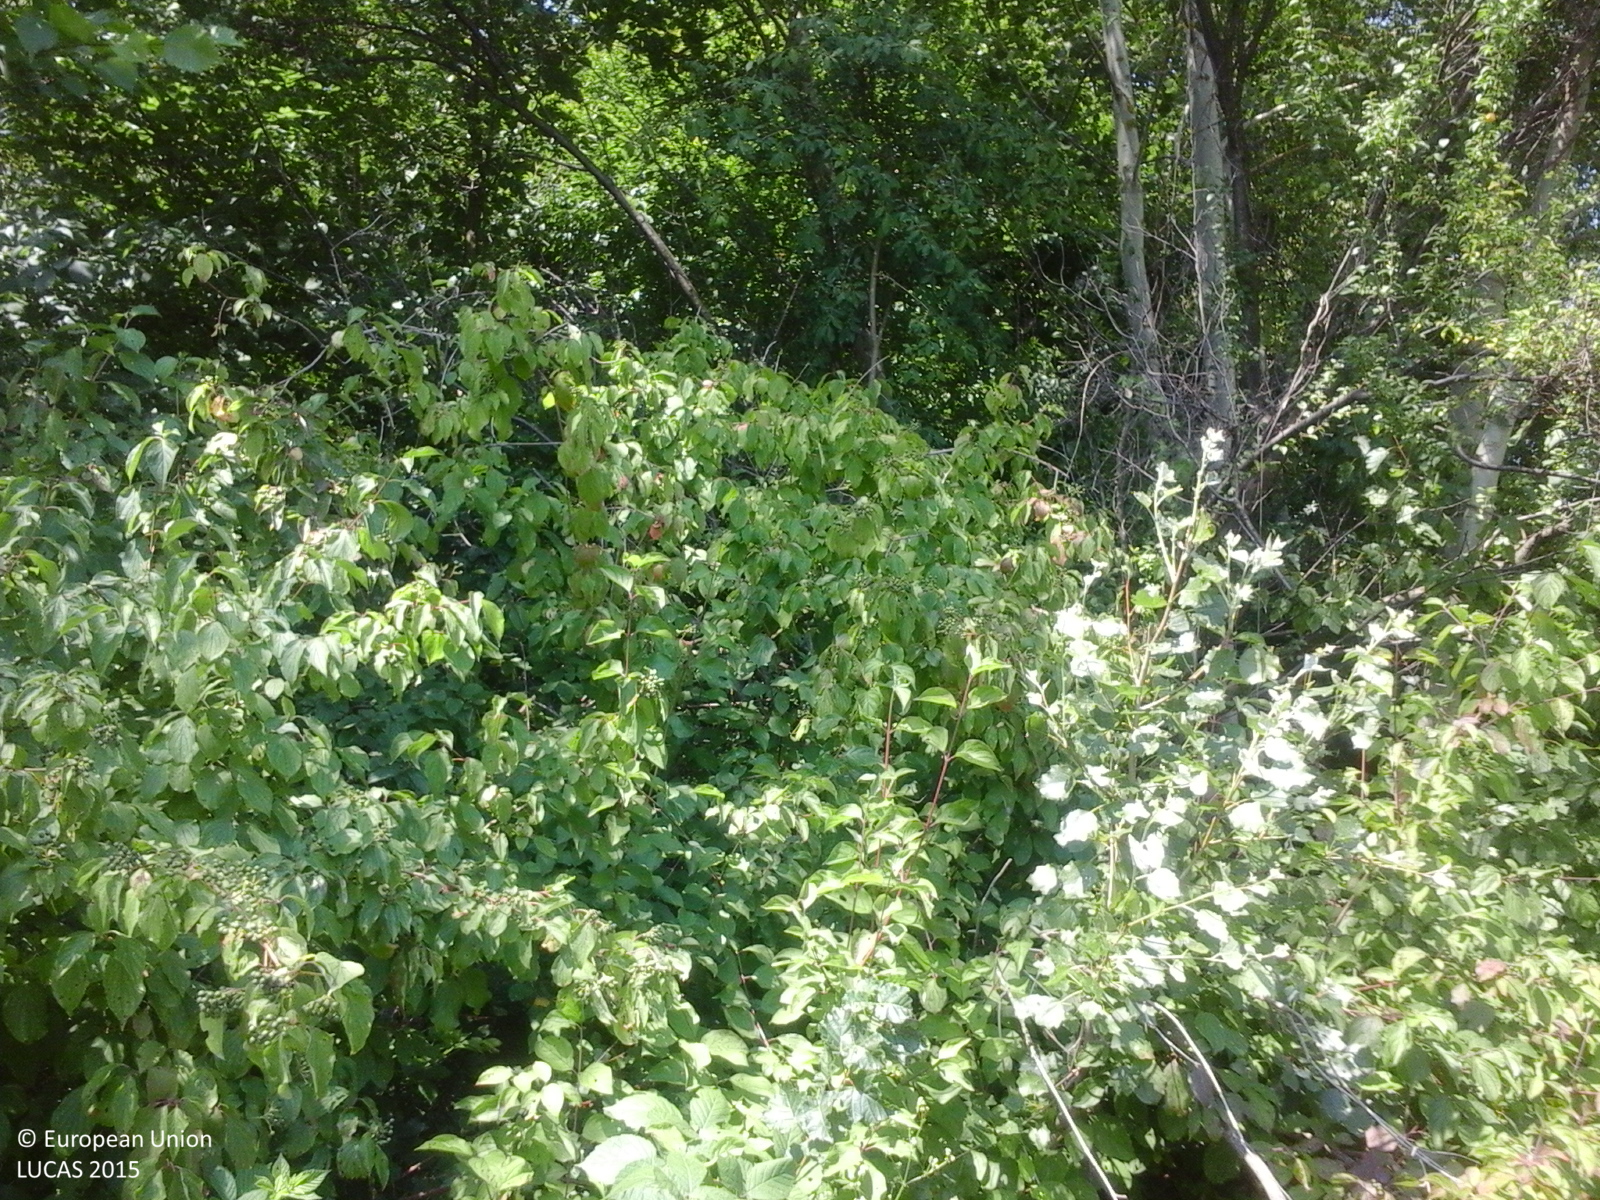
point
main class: Woodland
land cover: Broadleaved woodland
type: non-riverine alder, birch or aspen forest
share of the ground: > 75 %
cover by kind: broadleaved forest trees 100 %
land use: Forestry
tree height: > 5 m
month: July
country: RO
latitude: 44.8045
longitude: 24.5251
